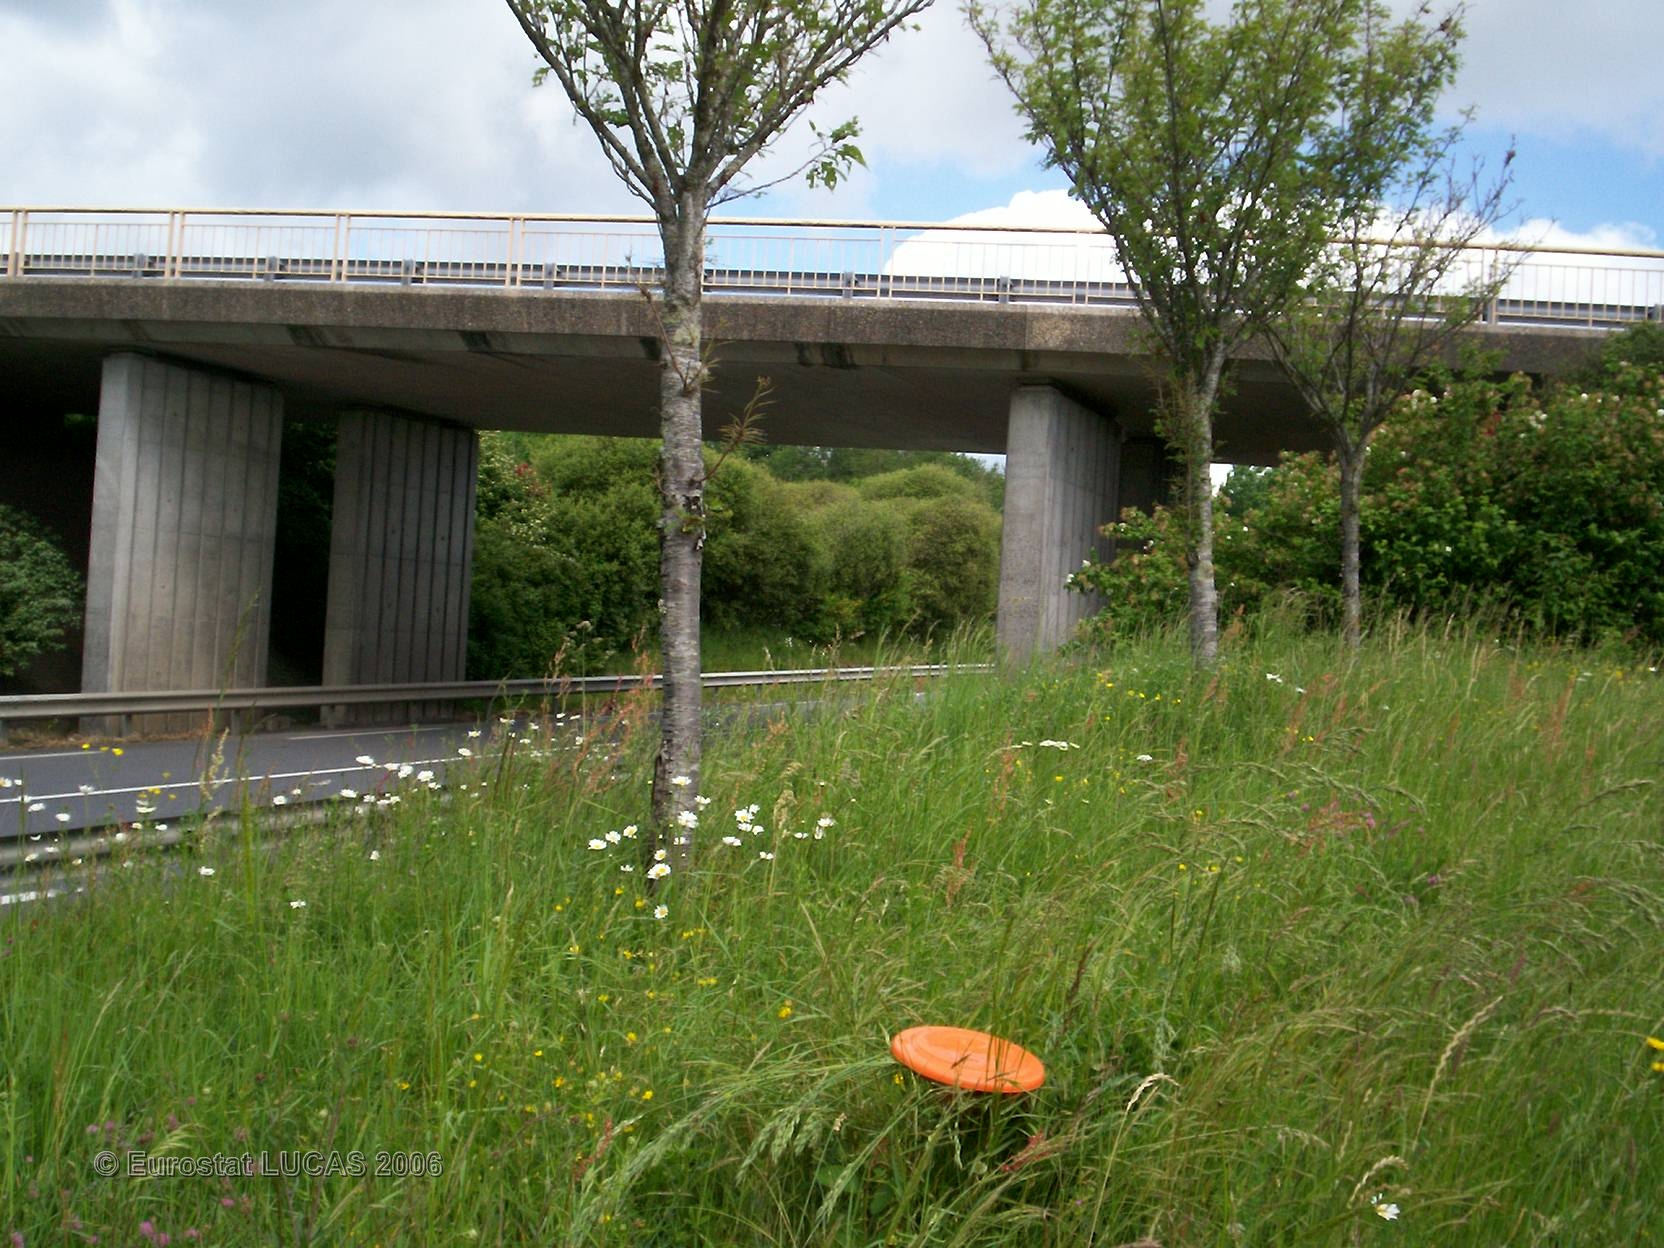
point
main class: Grassland
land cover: Grassland with sparse tree/shrub cover
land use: Unused
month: May
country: FR
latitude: 46.0512
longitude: 0.6673
